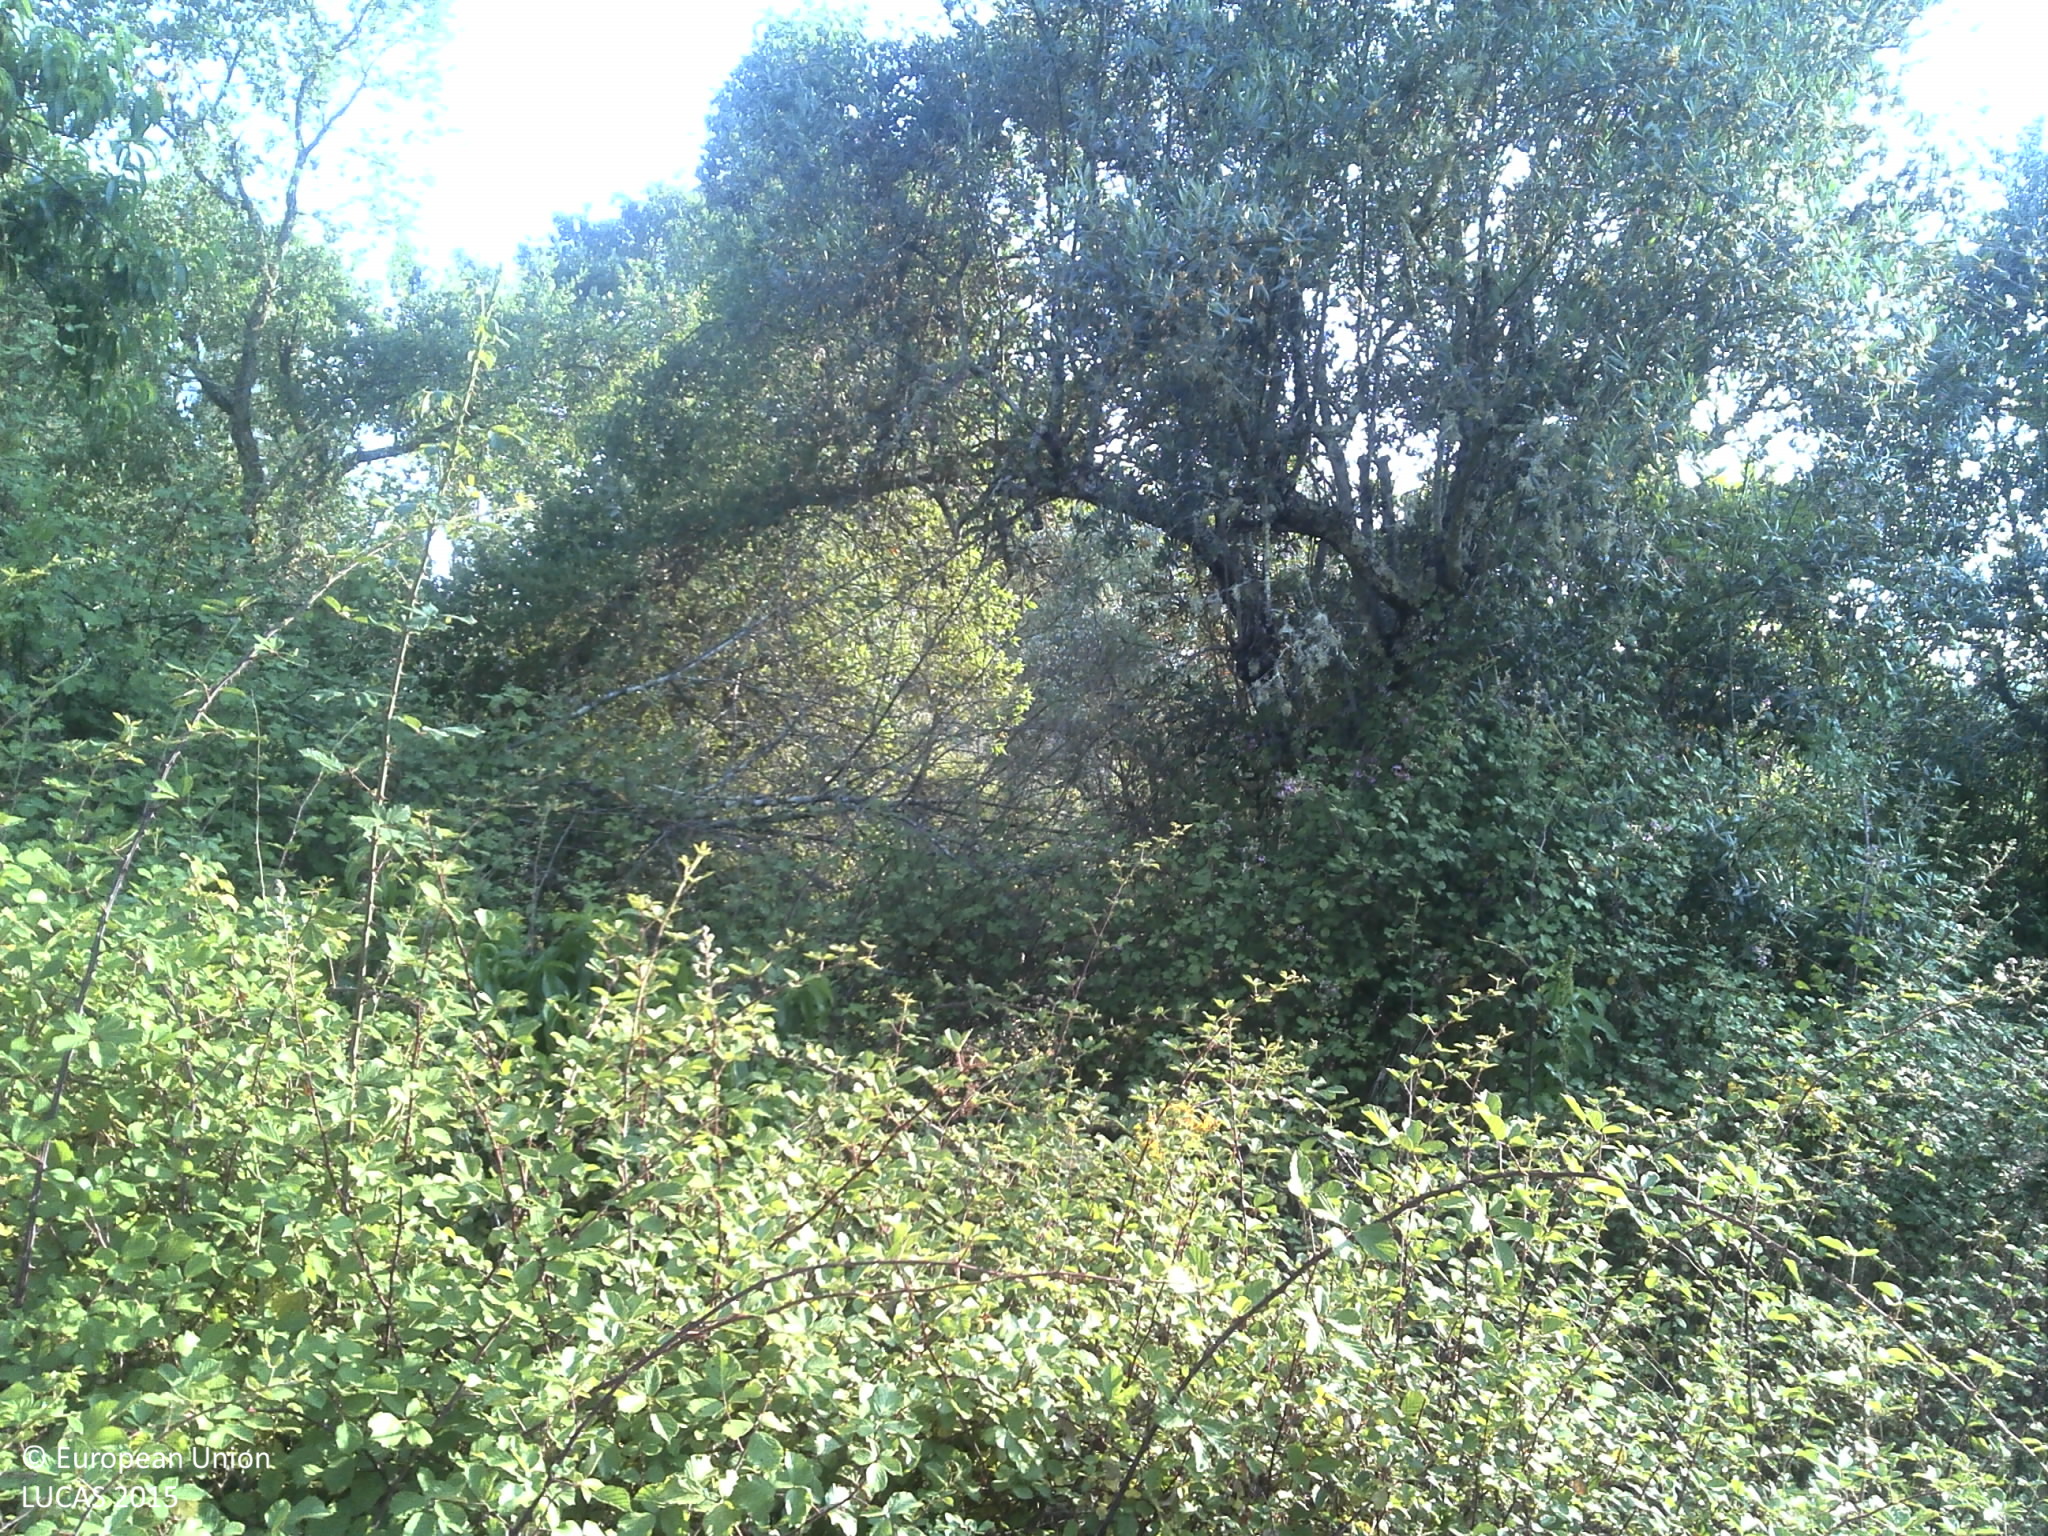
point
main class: Cropland
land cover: Olive groves
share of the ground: 25 - 50 %
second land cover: Shrubland without tree cover
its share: 50 - 75 %
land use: Agriculture (excluding fallow land and kitchen gardens)
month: June
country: PT
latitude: 39.3654
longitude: -7.9887
